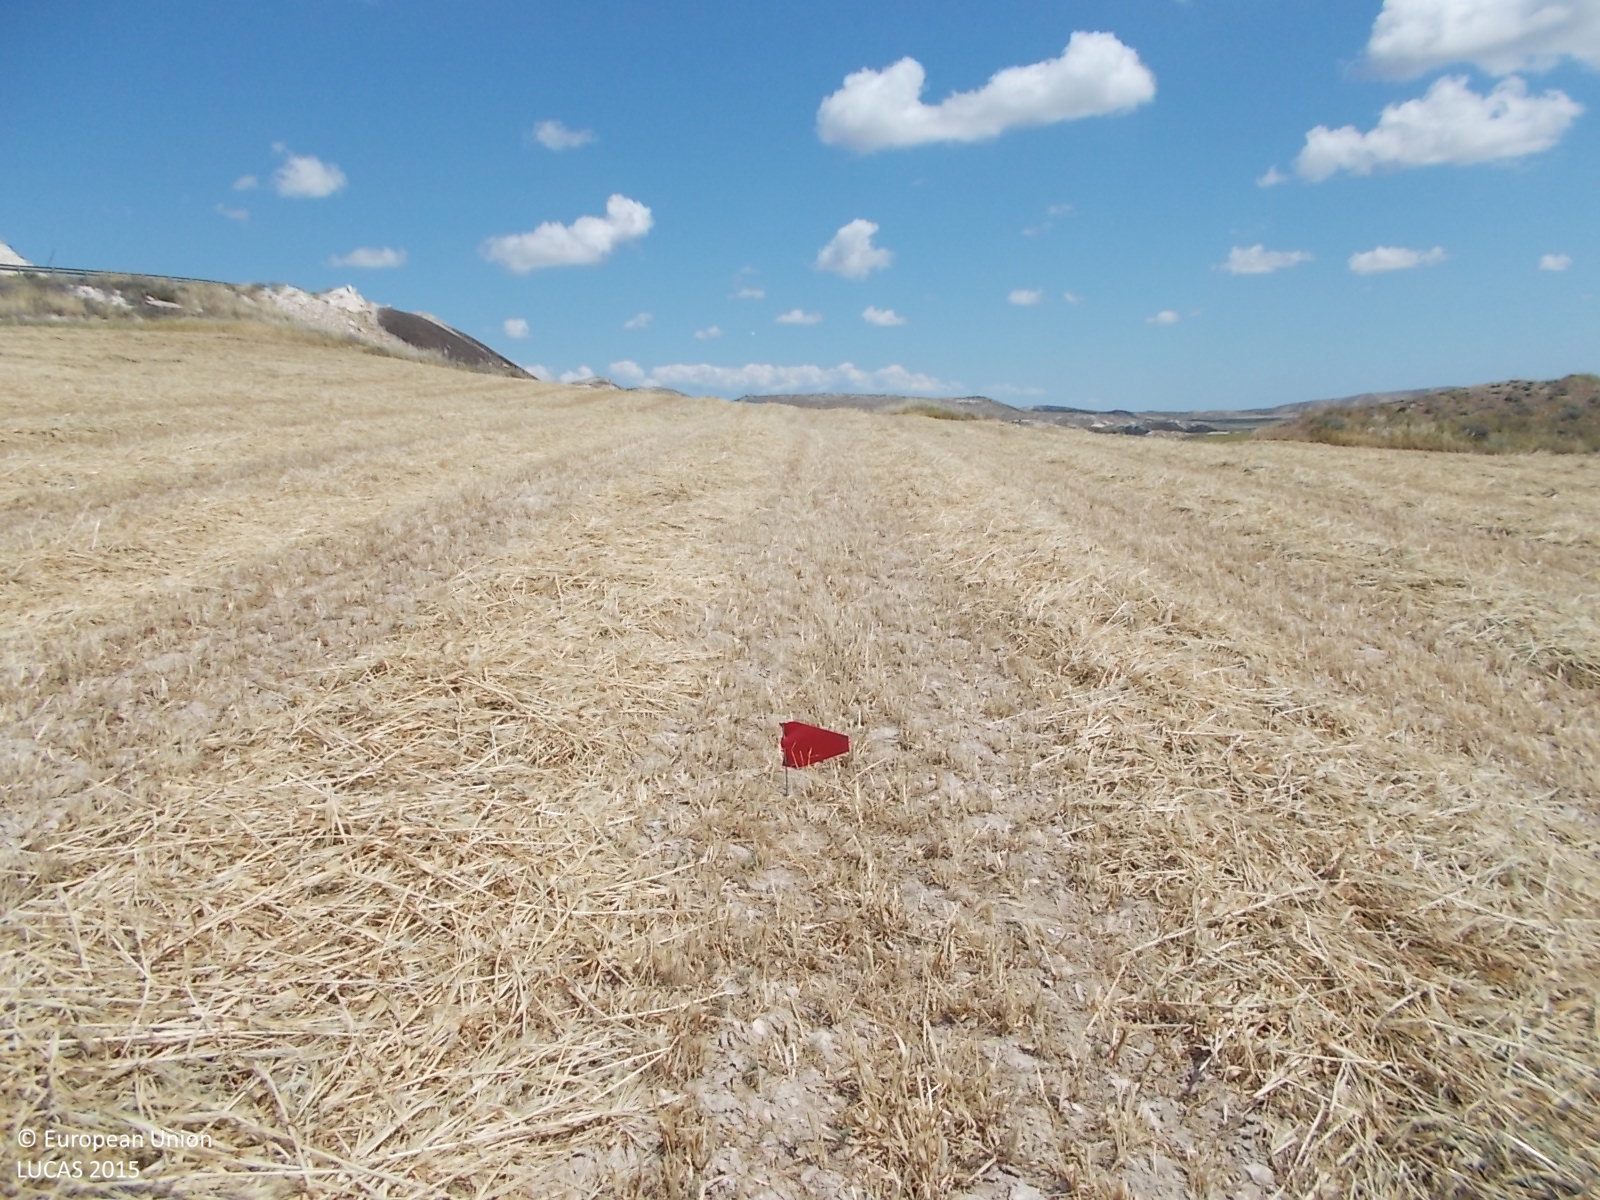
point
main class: Cropland
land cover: Mixed cereals for fodder
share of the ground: < 10 %
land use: Agriculture (excluding fallow land and kitchen gardens)
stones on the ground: < 10 %
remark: Harvested field
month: April
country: CY
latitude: 35.0207
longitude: 33.5744
